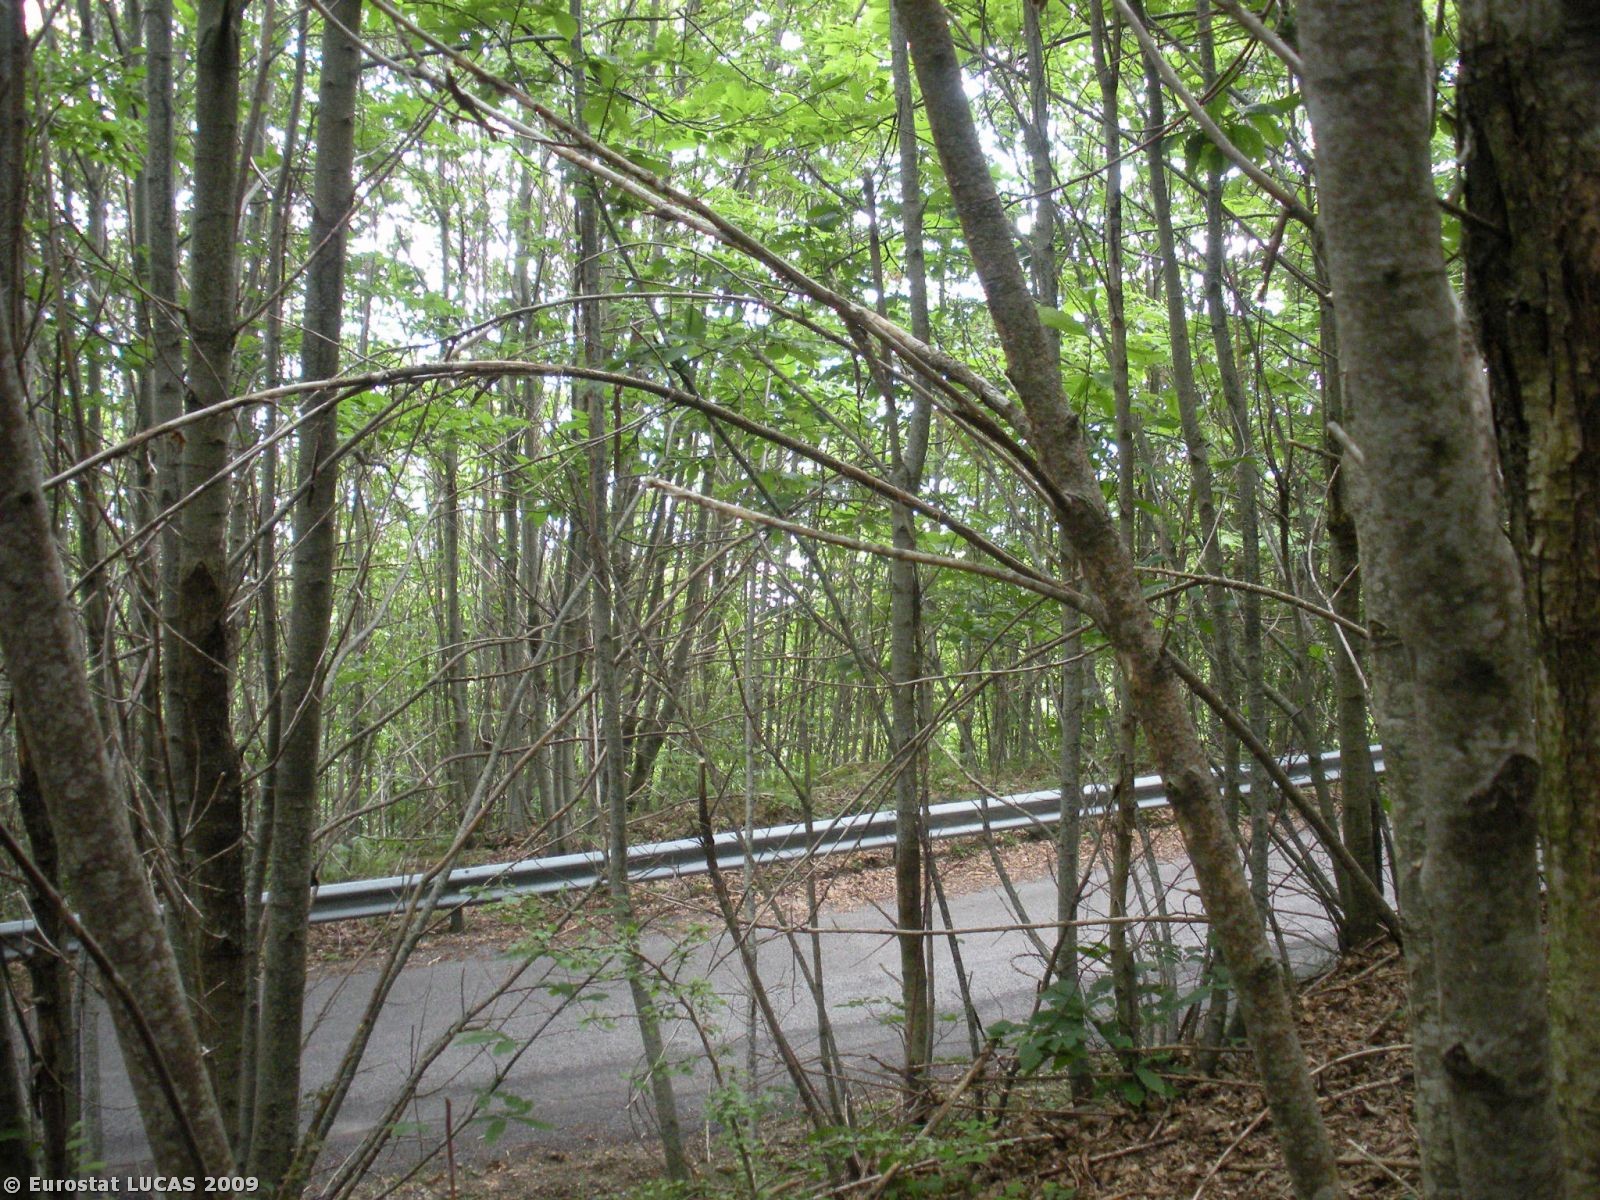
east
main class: Woodland
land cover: Broadleaved woodland
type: mesophytic deciduous forest
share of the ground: > 75 %
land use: Agriculture (excluding fallow land and kitchen gardens)
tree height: > 5 m
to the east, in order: Broadleaved woodland; Ditches and canals; Paved roads, cycling and walking lanes; Fences; Broadleaved woodland; Paved roads, cycling and walking lanes; Broadleaved woodland; Ditches and canals; Paved roads, cycling and walking lanes; Fences; Broadleaved woodland
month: July
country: IT
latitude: 40.2451
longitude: 15.0675
